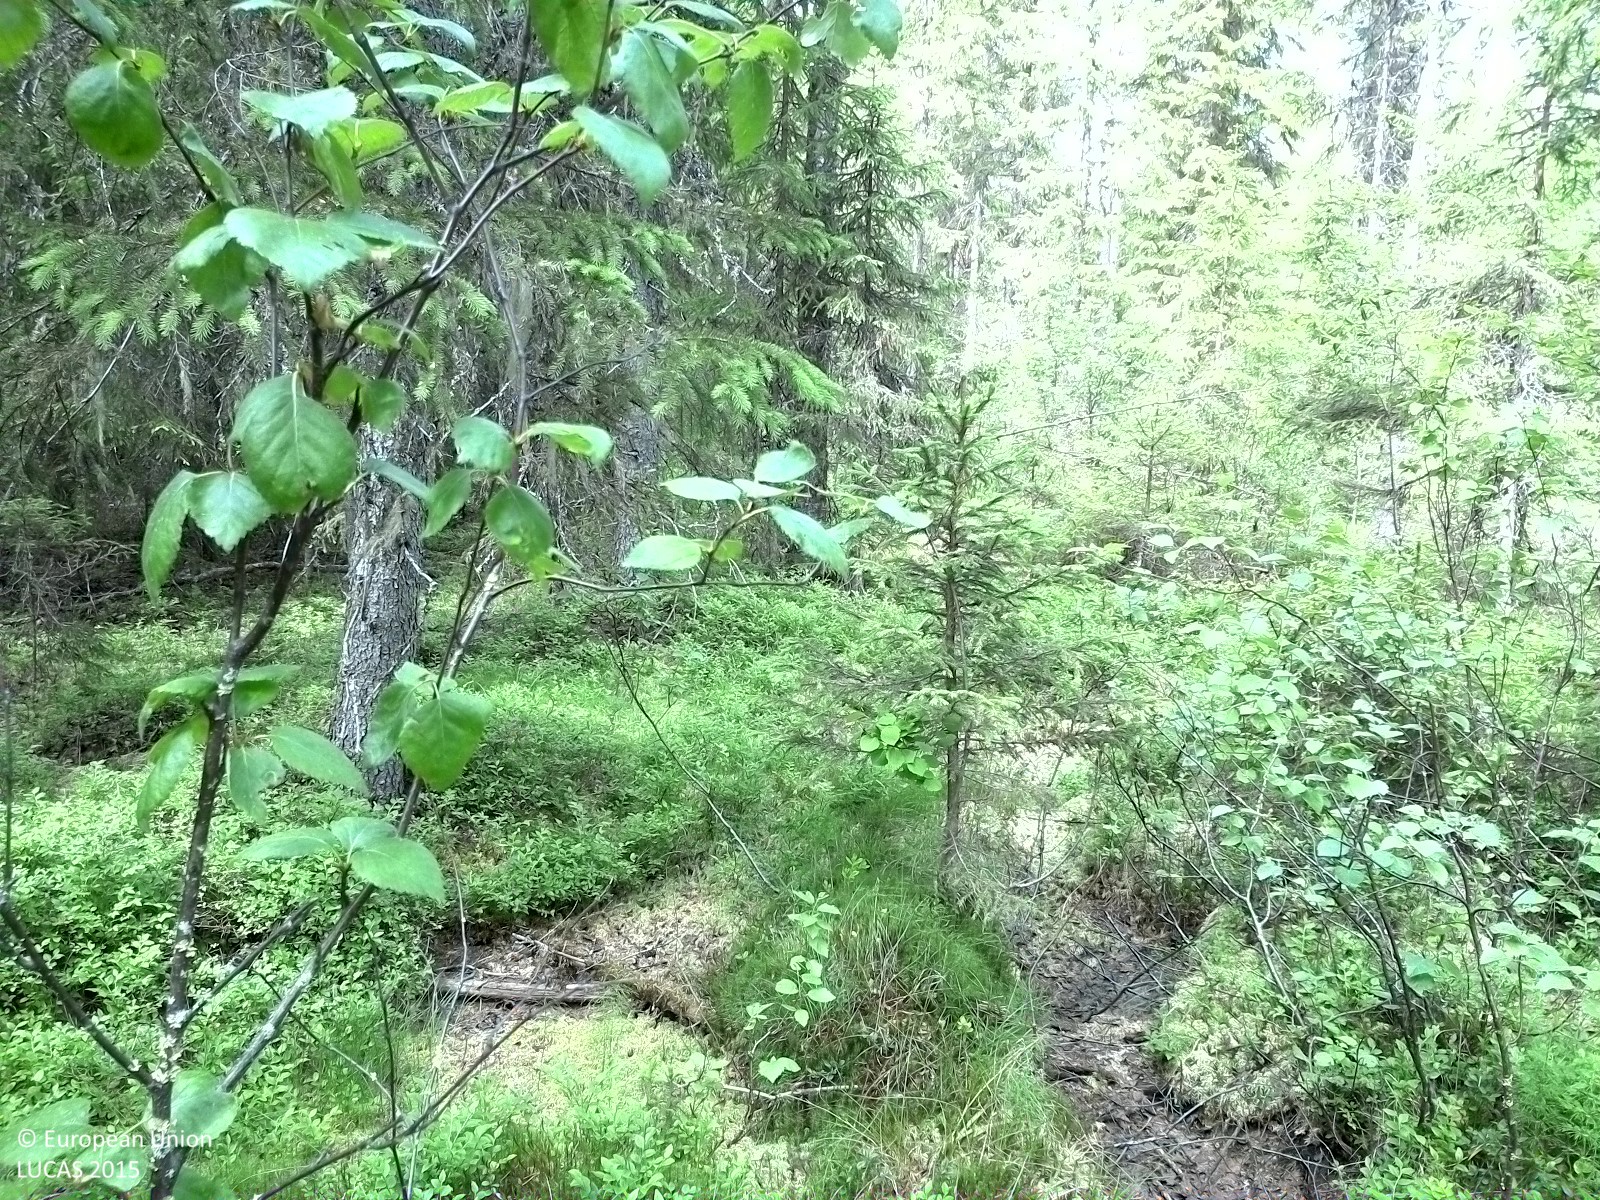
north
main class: Woodland
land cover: Spruce dominated coniferous woodland
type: boreal forest
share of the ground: 25 - 50 %
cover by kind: coniferous forest trees 40 %, lichens and mosses 30 %, shrubs 25 %, broadleaved forest trees 5 %
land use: Forestry
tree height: > 5 m
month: July
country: SE
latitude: 62.1495
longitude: 16.8313
